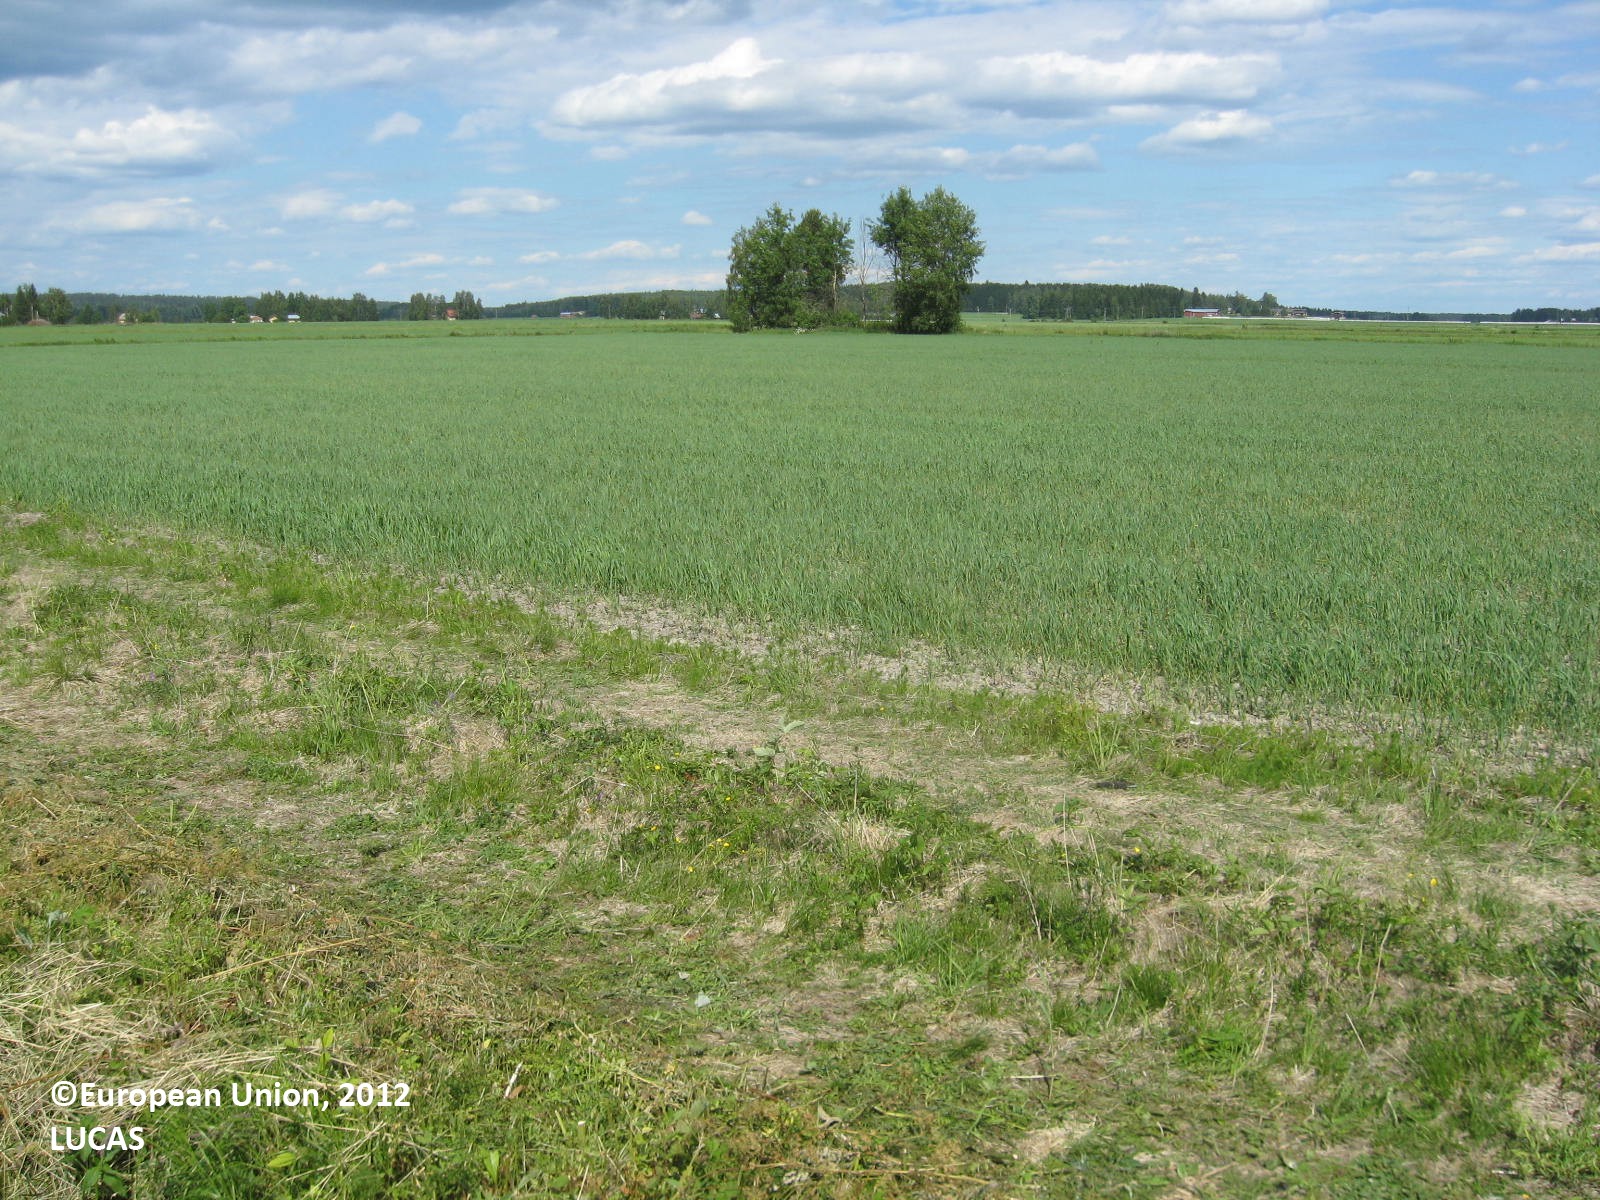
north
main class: Cropland
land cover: Oats
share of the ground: > 75 %
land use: Agriculture (excluding fallow land and kitchen gardens)
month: July
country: FI
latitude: 62.6013
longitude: 22.5018
